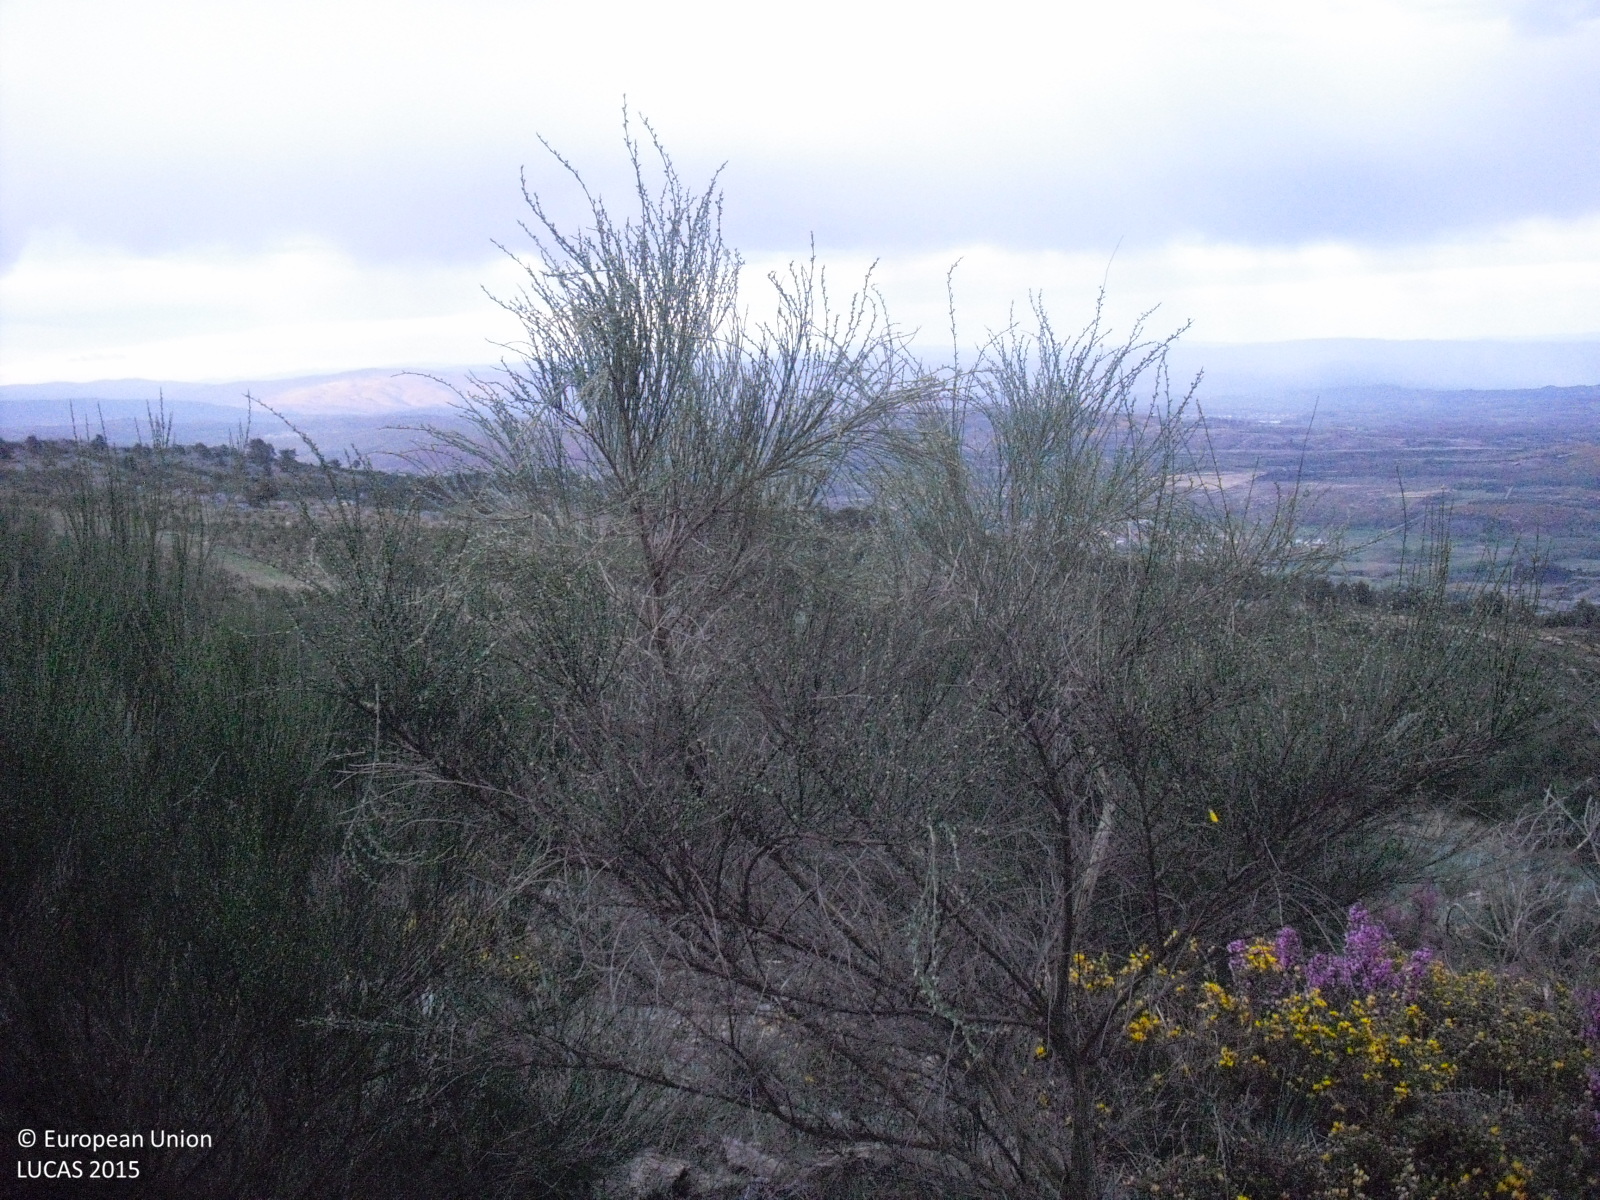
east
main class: Shrubland
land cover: Shrubland without tree cover
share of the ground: > 75 %
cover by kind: shrubs 70 %, herbaceous plants 15 %, consolidated bare surface 15 %
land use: Forestry
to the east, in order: Shrubland without tree cover; Rock outcrops; Shrubland without tree cover; Pine dominated coniferous woodland; Tracks; Shrubland without tree cover; Rock outcrops; Pine dominated coniferous woodland; Rock outcrops; Shrubland without tree cover; Pine dominated coniferous woodland
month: April
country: ES
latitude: 41.9357
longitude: -7.6624
